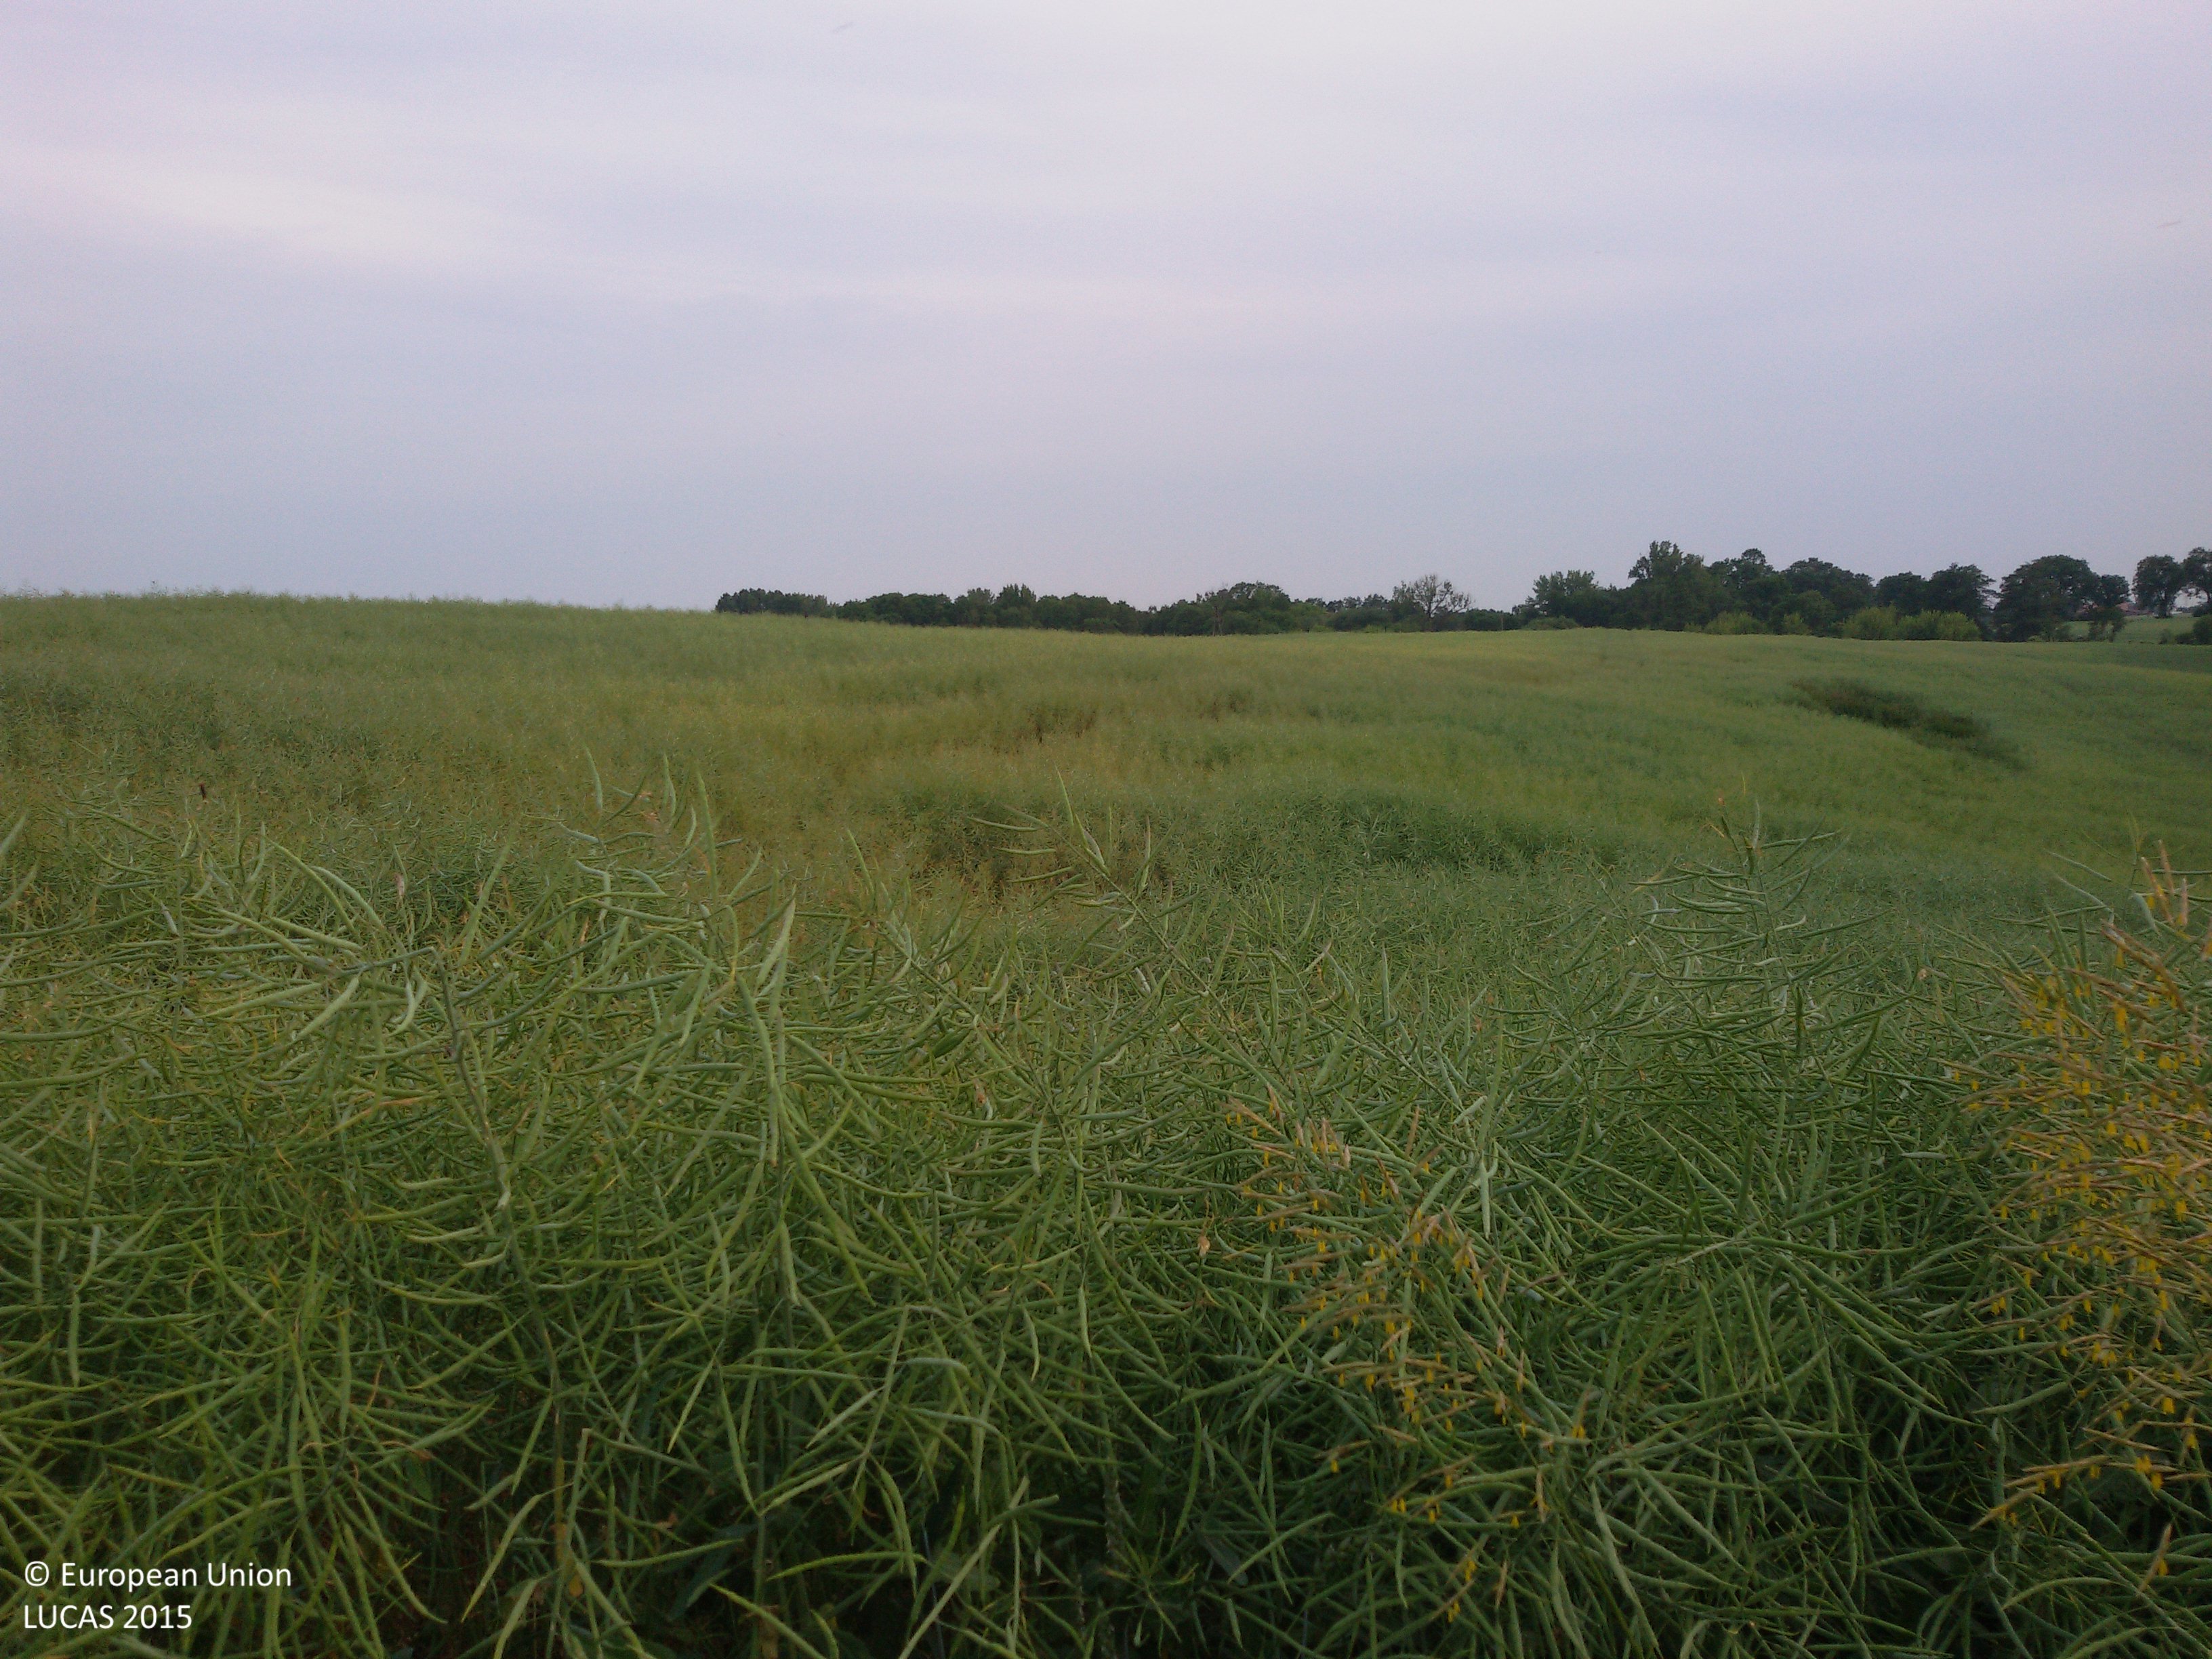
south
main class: Cropland
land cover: Rape and turnip rape
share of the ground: > 75 %
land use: Agriculture (excluding fallow land and kitchen gardens)
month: June
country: PL
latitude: 52.5392
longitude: 19.0318
